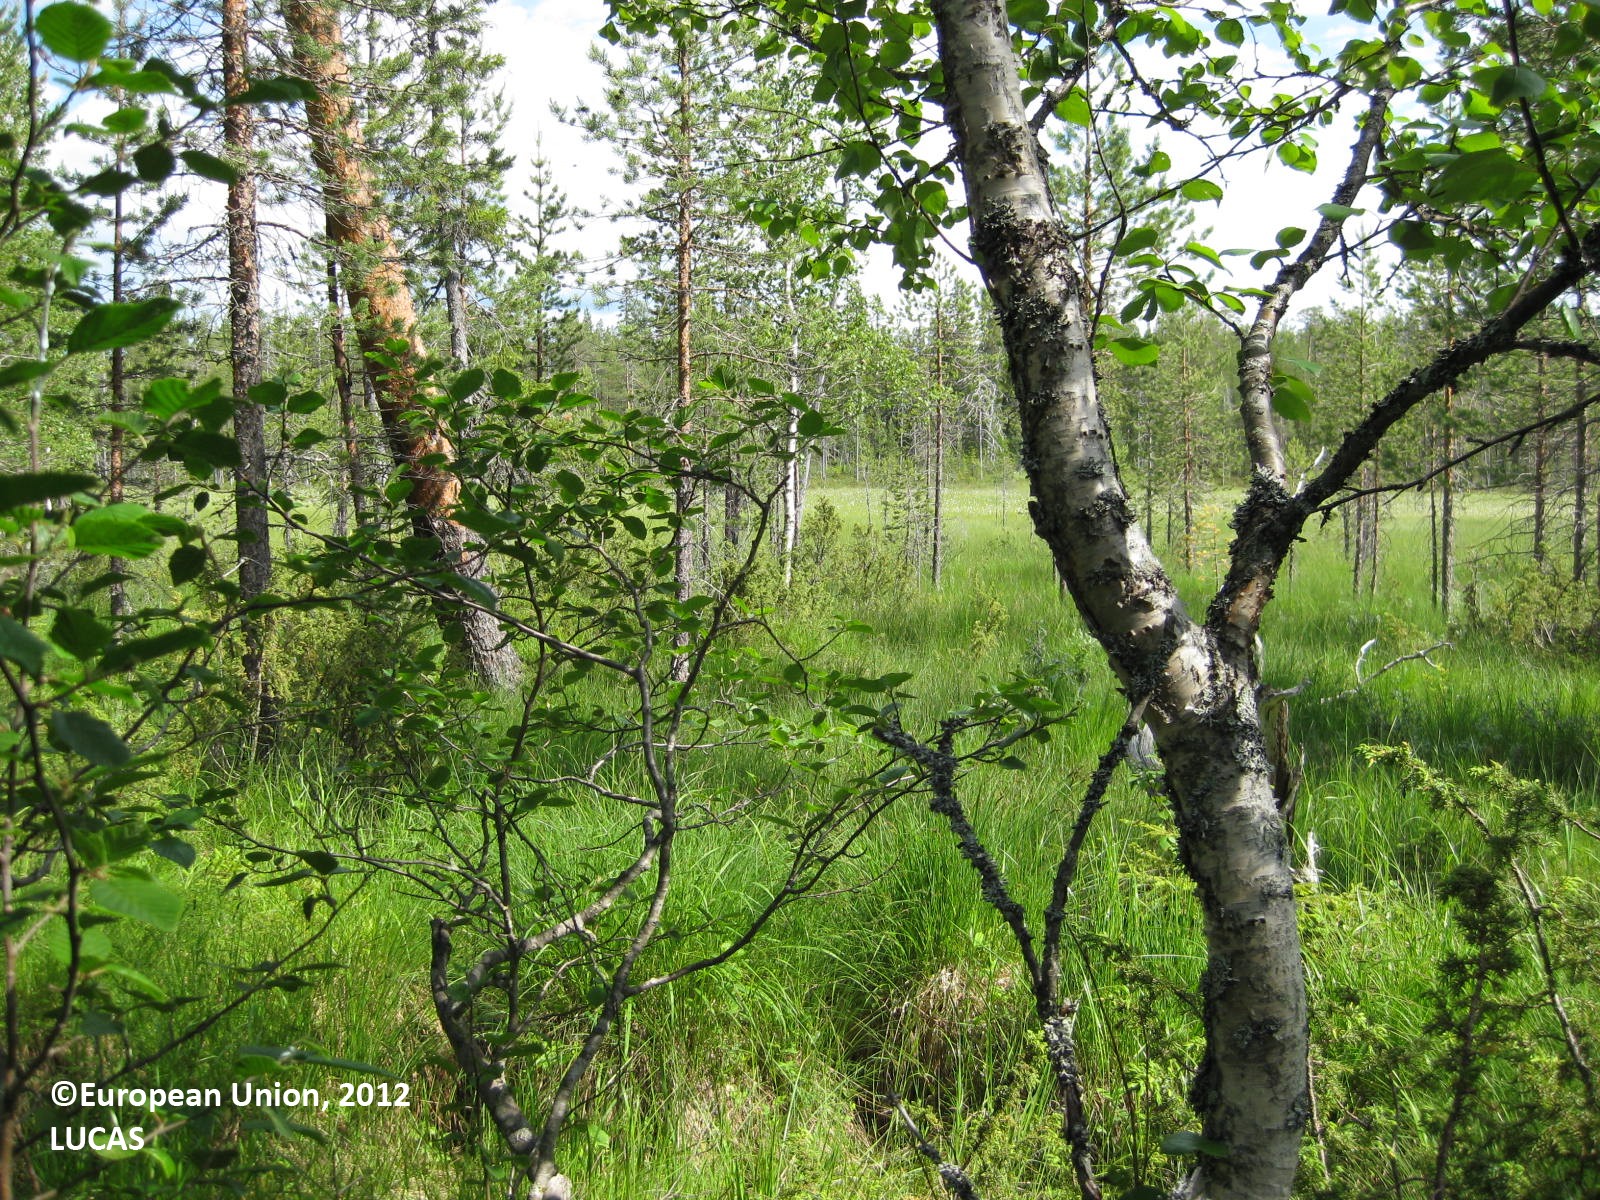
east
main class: Woodland
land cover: Pine dominated mixed woodland
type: boreal forest
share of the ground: > 75 %
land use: Semi-natural and natural areas not in use
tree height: > 5 m
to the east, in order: Pine dominated mixed woodland; Pine dominated coniferous woodland; Peatbogs; Other coniferous woodland; Other mixed woodland; Pine dominated coniferous woodland
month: July
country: FI
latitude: 65.5372
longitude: 29.3000
